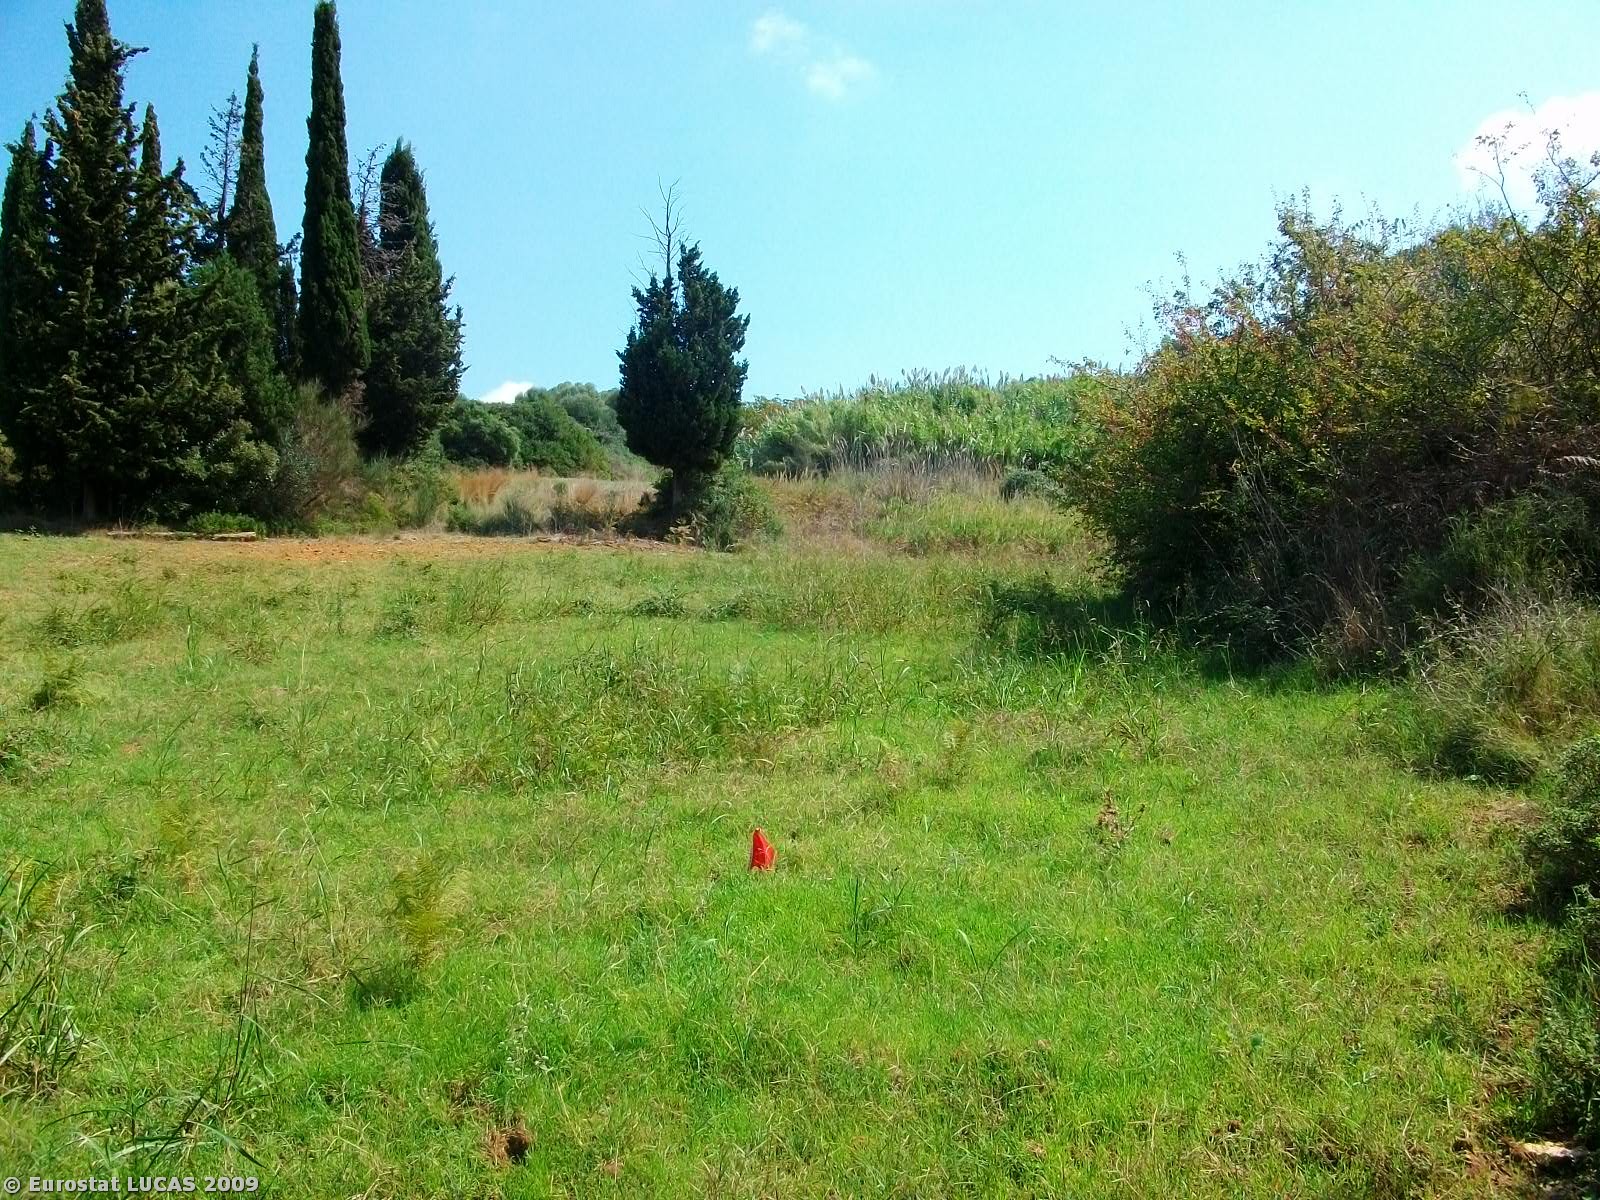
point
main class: Grassland
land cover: Grassland with sparse tree/shrub cover
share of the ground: > 75 %
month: September
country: GR
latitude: 37.7562
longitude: 21.3893
